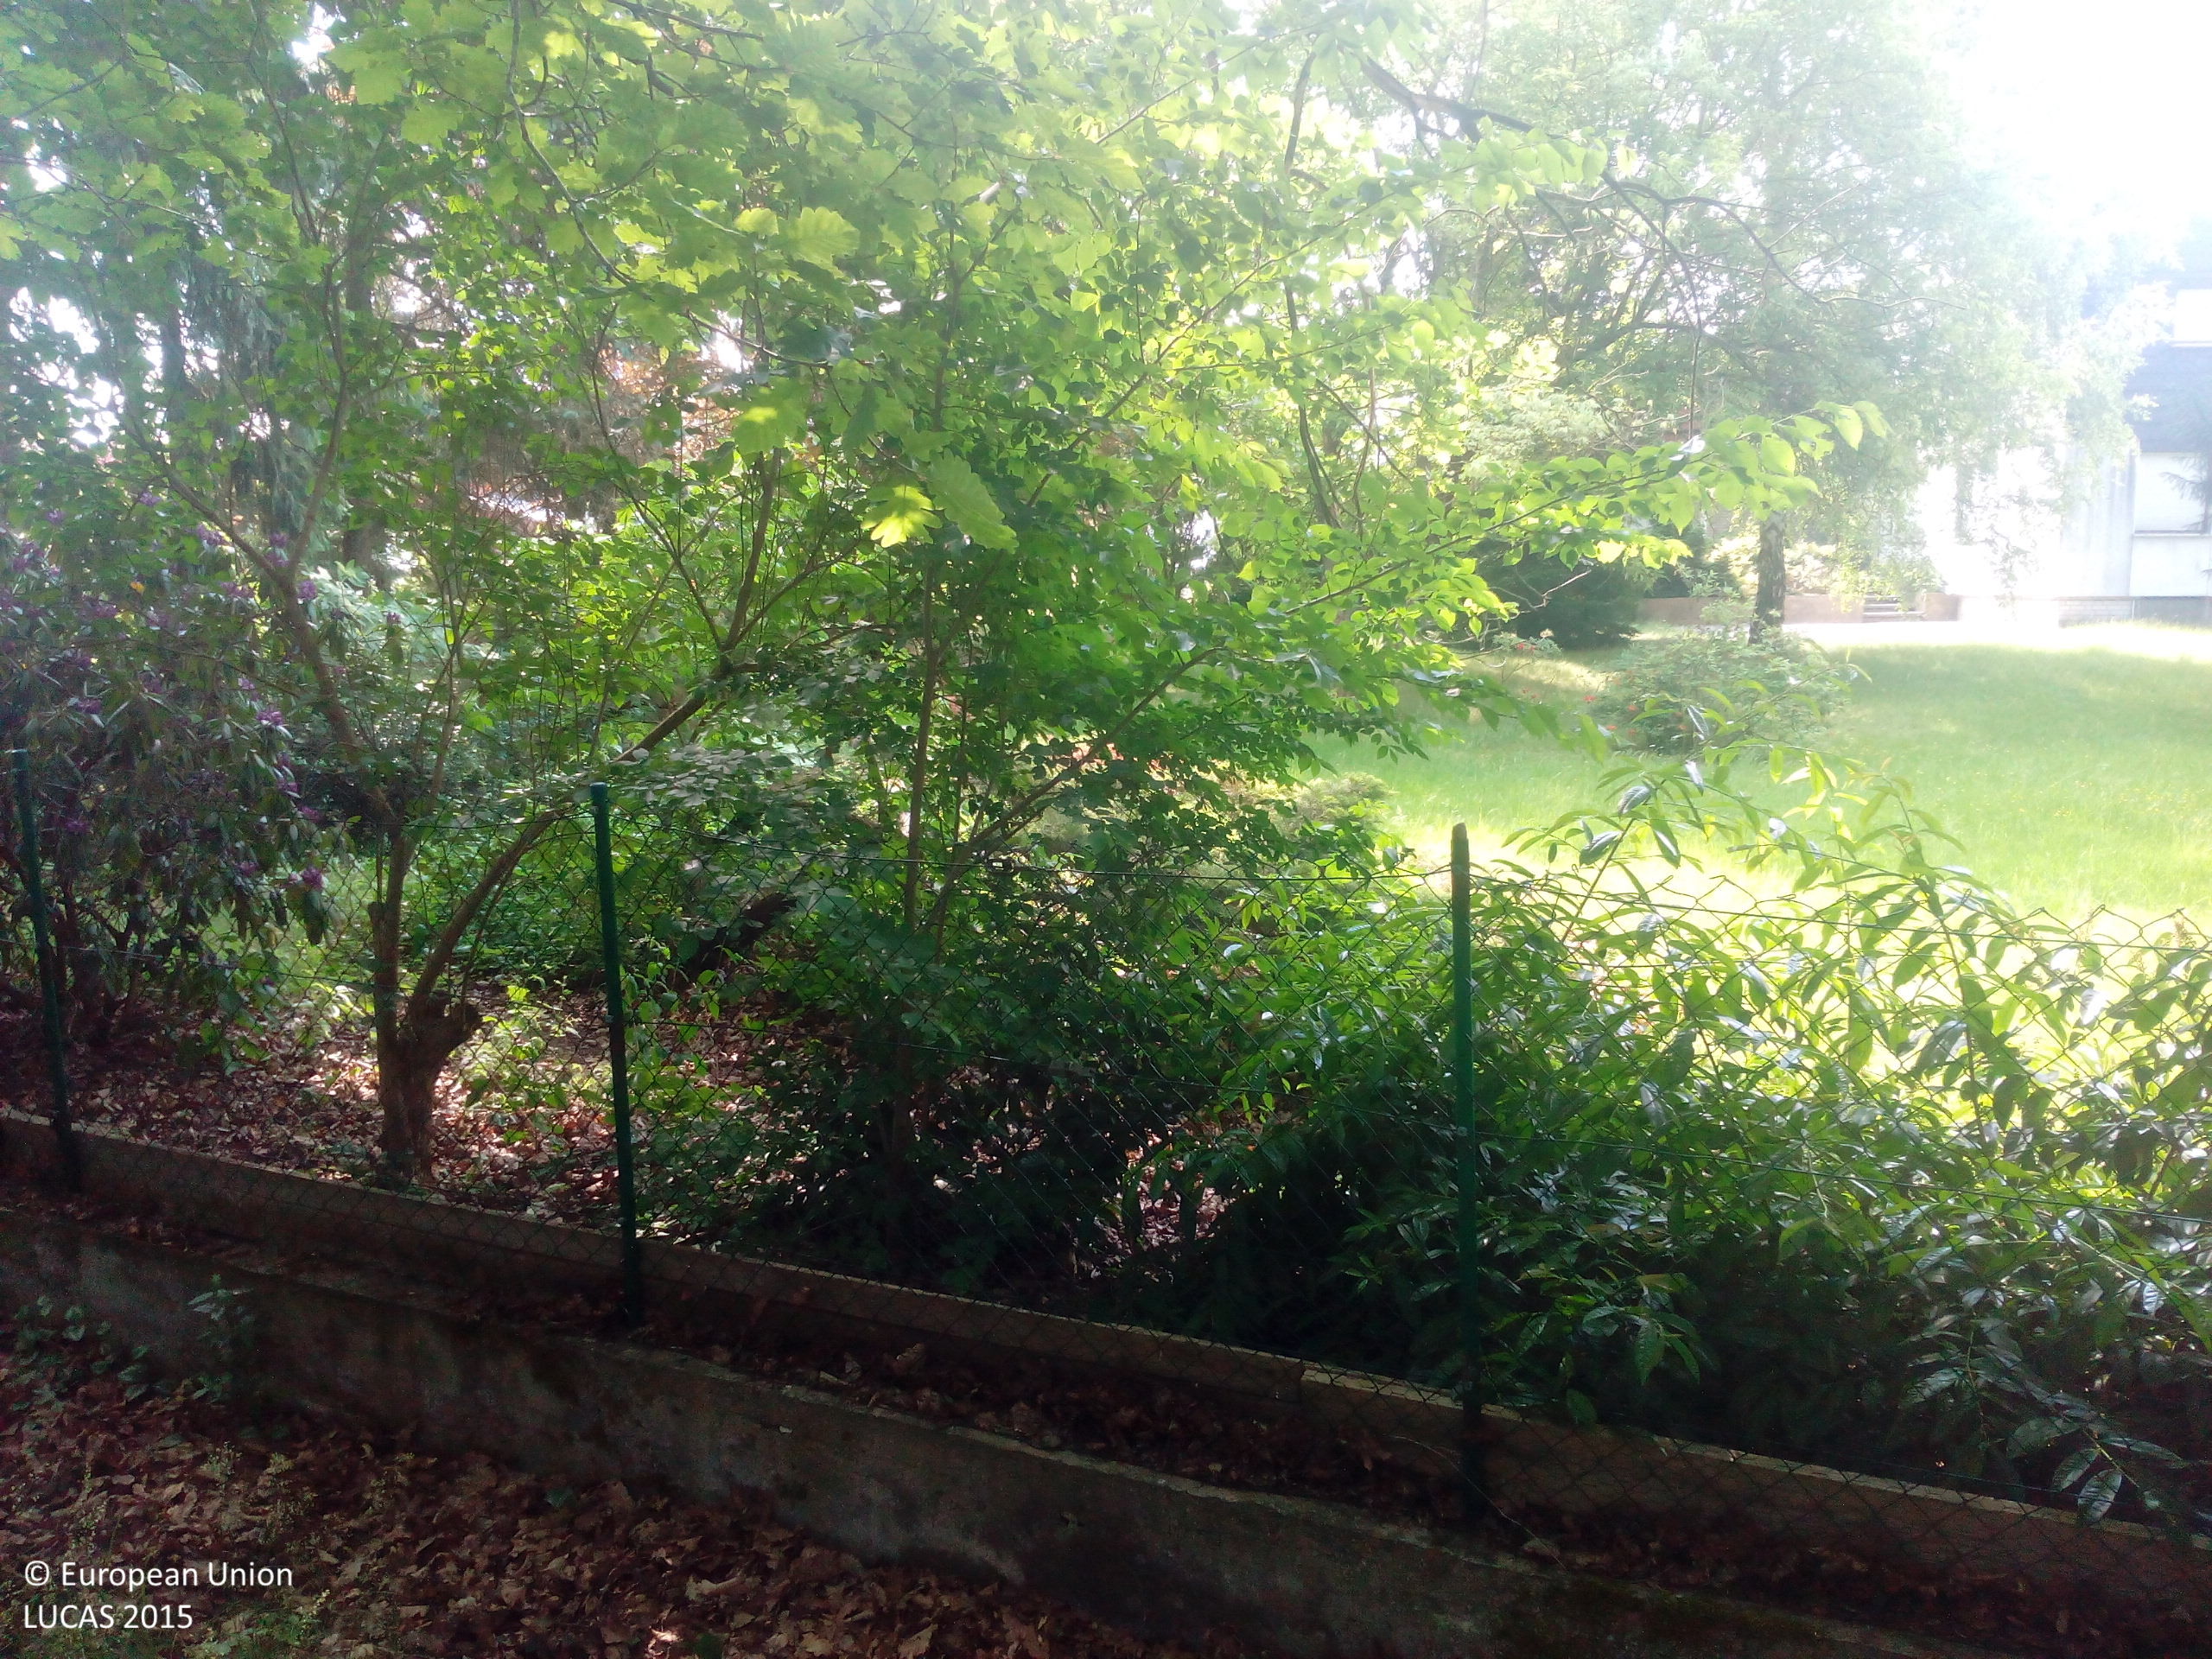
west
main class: Woodland
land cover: Other mixed woodland
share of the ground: > 75 %
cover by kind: broadleaved forest trees 65 %, coniferous forest trees 25 %, herbaceous plants 10 %
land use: Residential
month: June
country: DE
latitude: 52.4102
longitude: 10.8670
